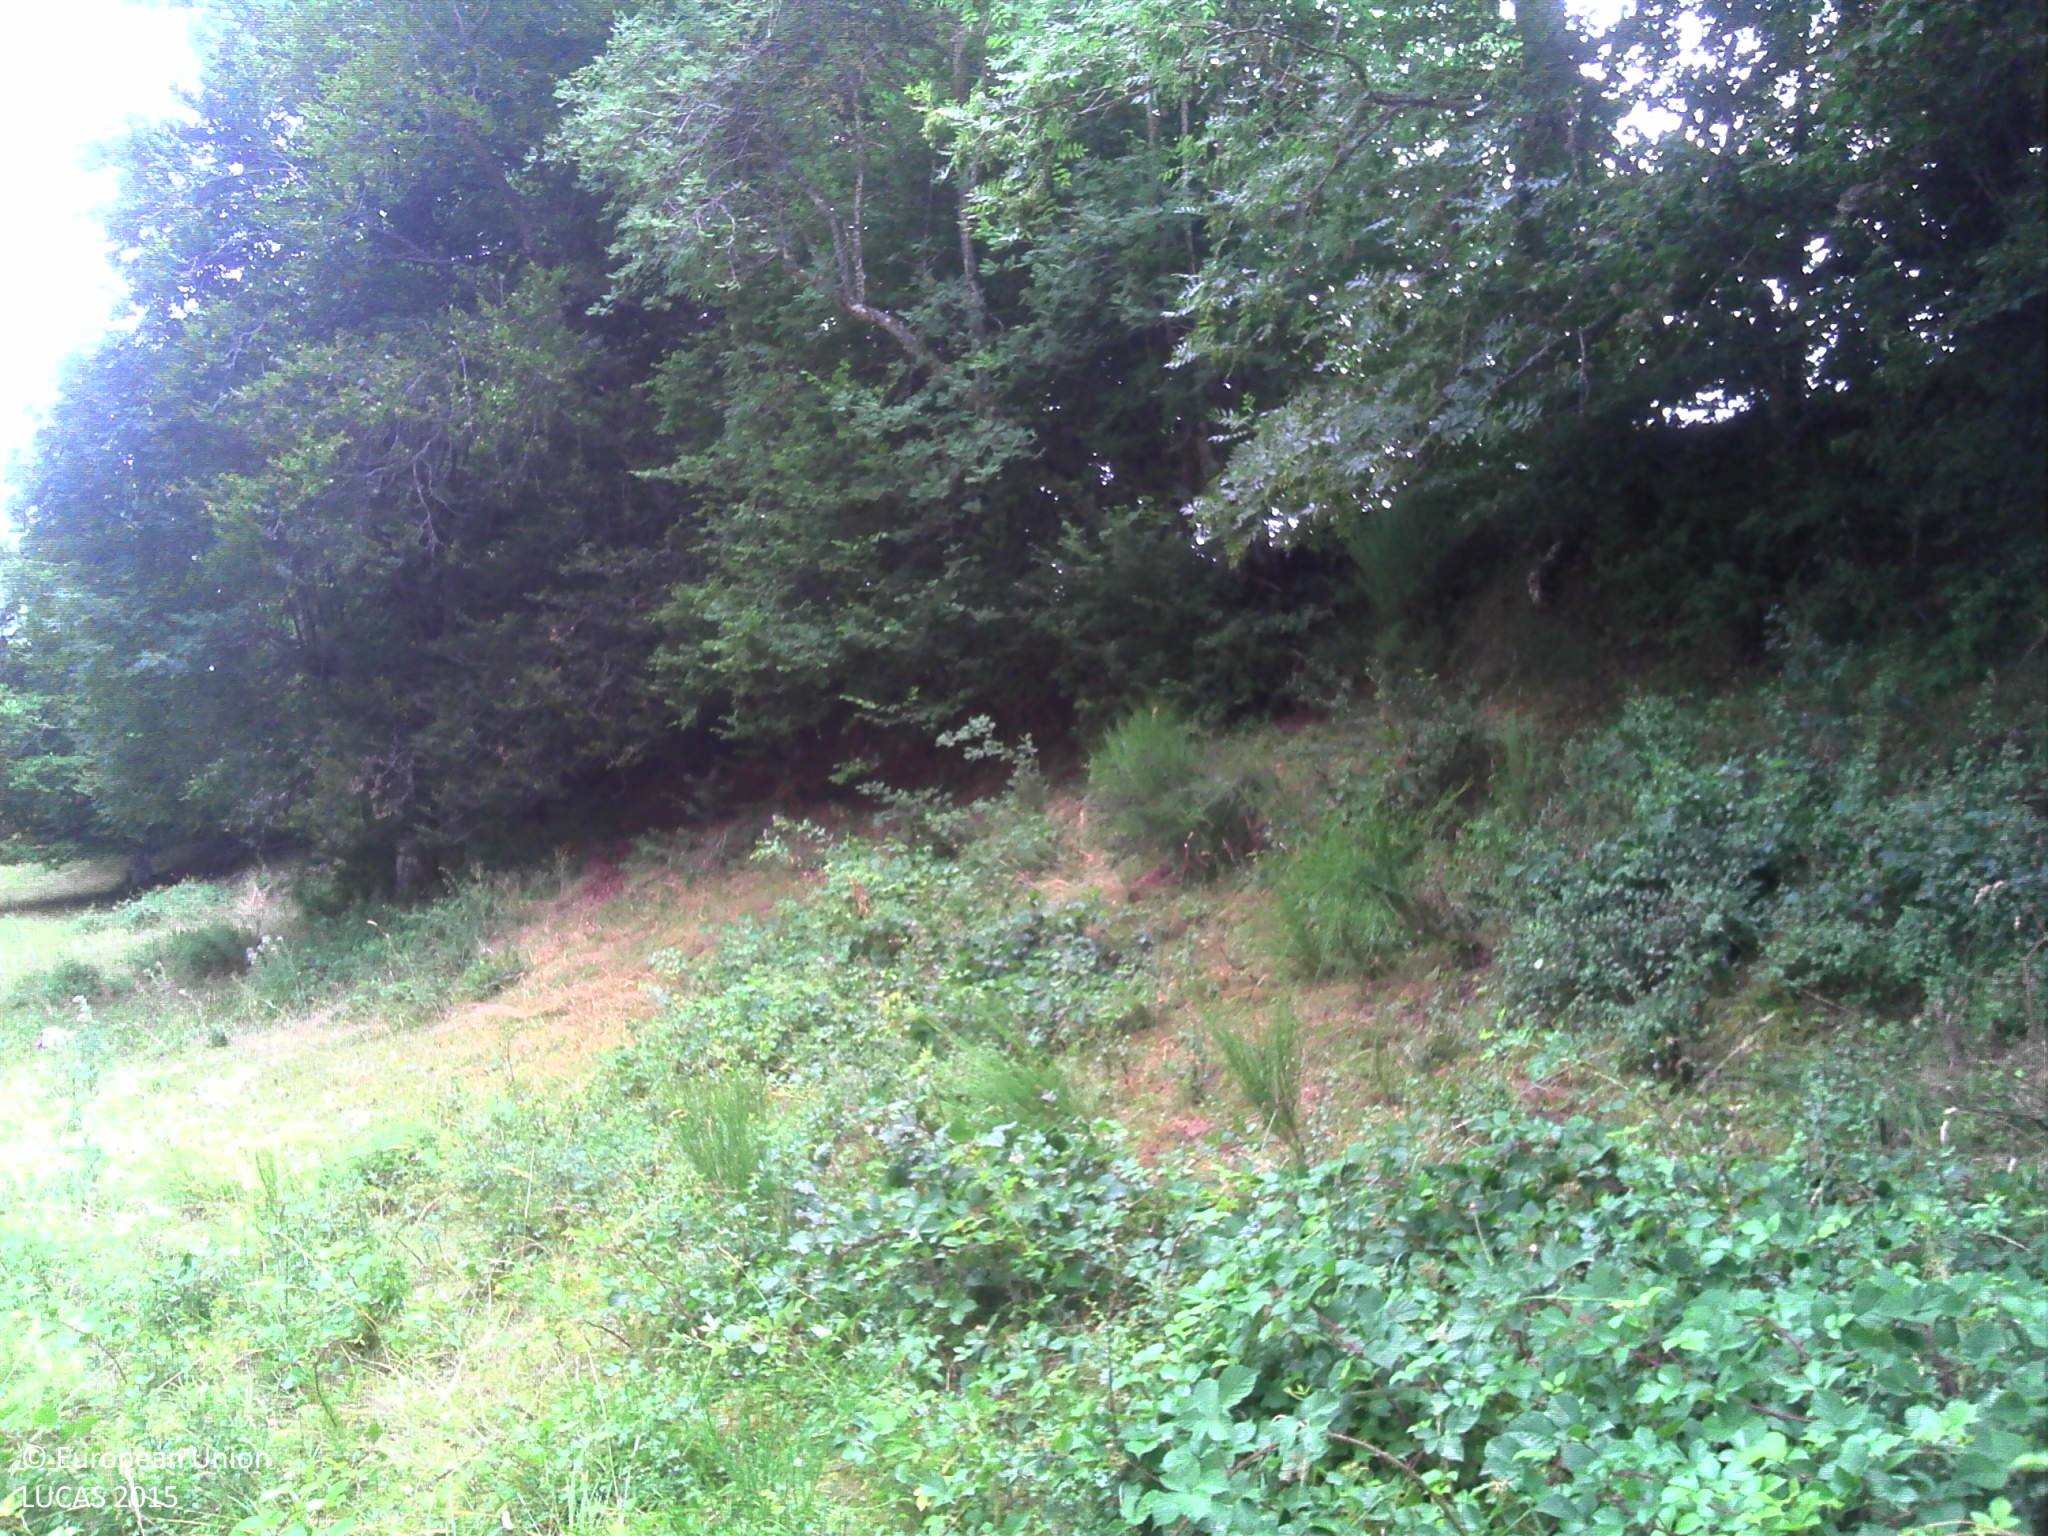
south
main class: Grassland
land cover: Grassland with sparse tree/shrub cover
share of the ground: > 75 %
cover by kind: herbaceous plants 95 %, broadleaved forest trees 5 %
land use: Agriculture (excluding fallow land and kitchen gardens)
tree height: > 5 m
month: July
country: FR
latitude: 44.8058
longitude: 3.0619
